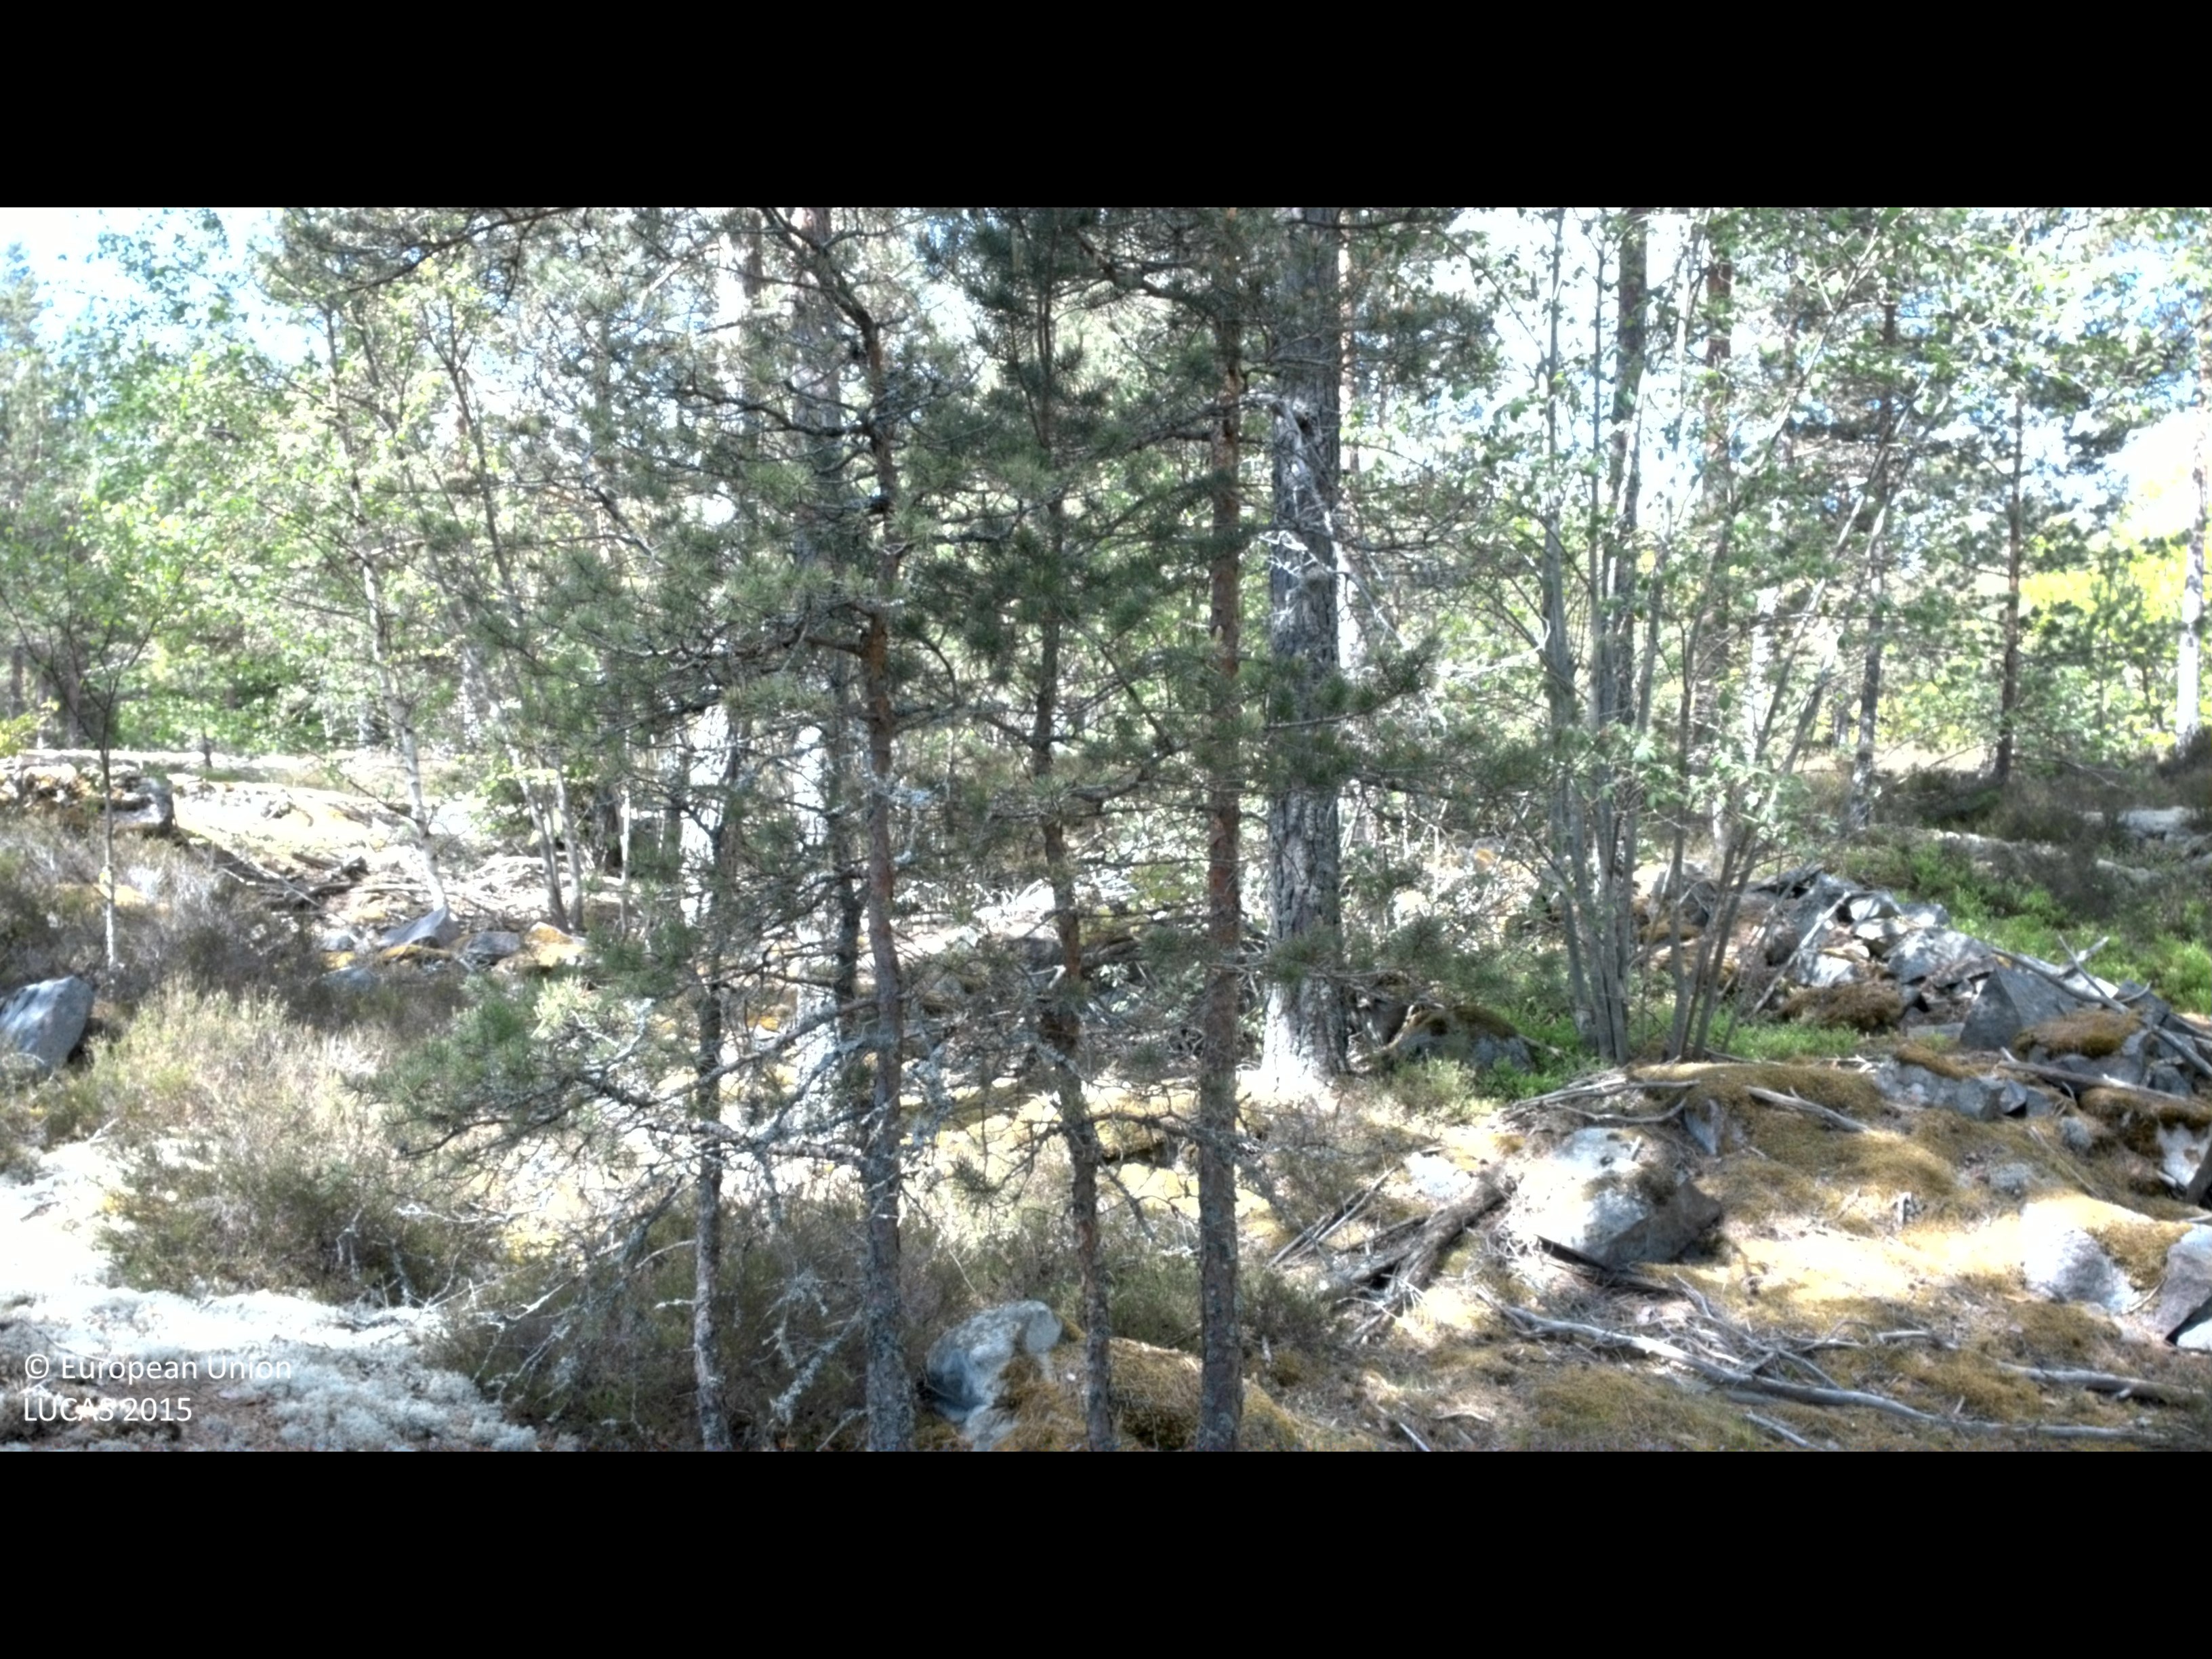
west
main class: Woodland
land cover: Pine dominated coniferous woodland
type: boreal forest
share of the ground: 50 - 75 %
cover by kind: coniferous forest trees 65 %, shrubs 15 %, lichens and mosses 15 %, broadleaved forest trees 5 %
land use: Forestry
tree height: > 5 m
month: May
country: SE
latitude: 57.5340
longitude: 16.5970
